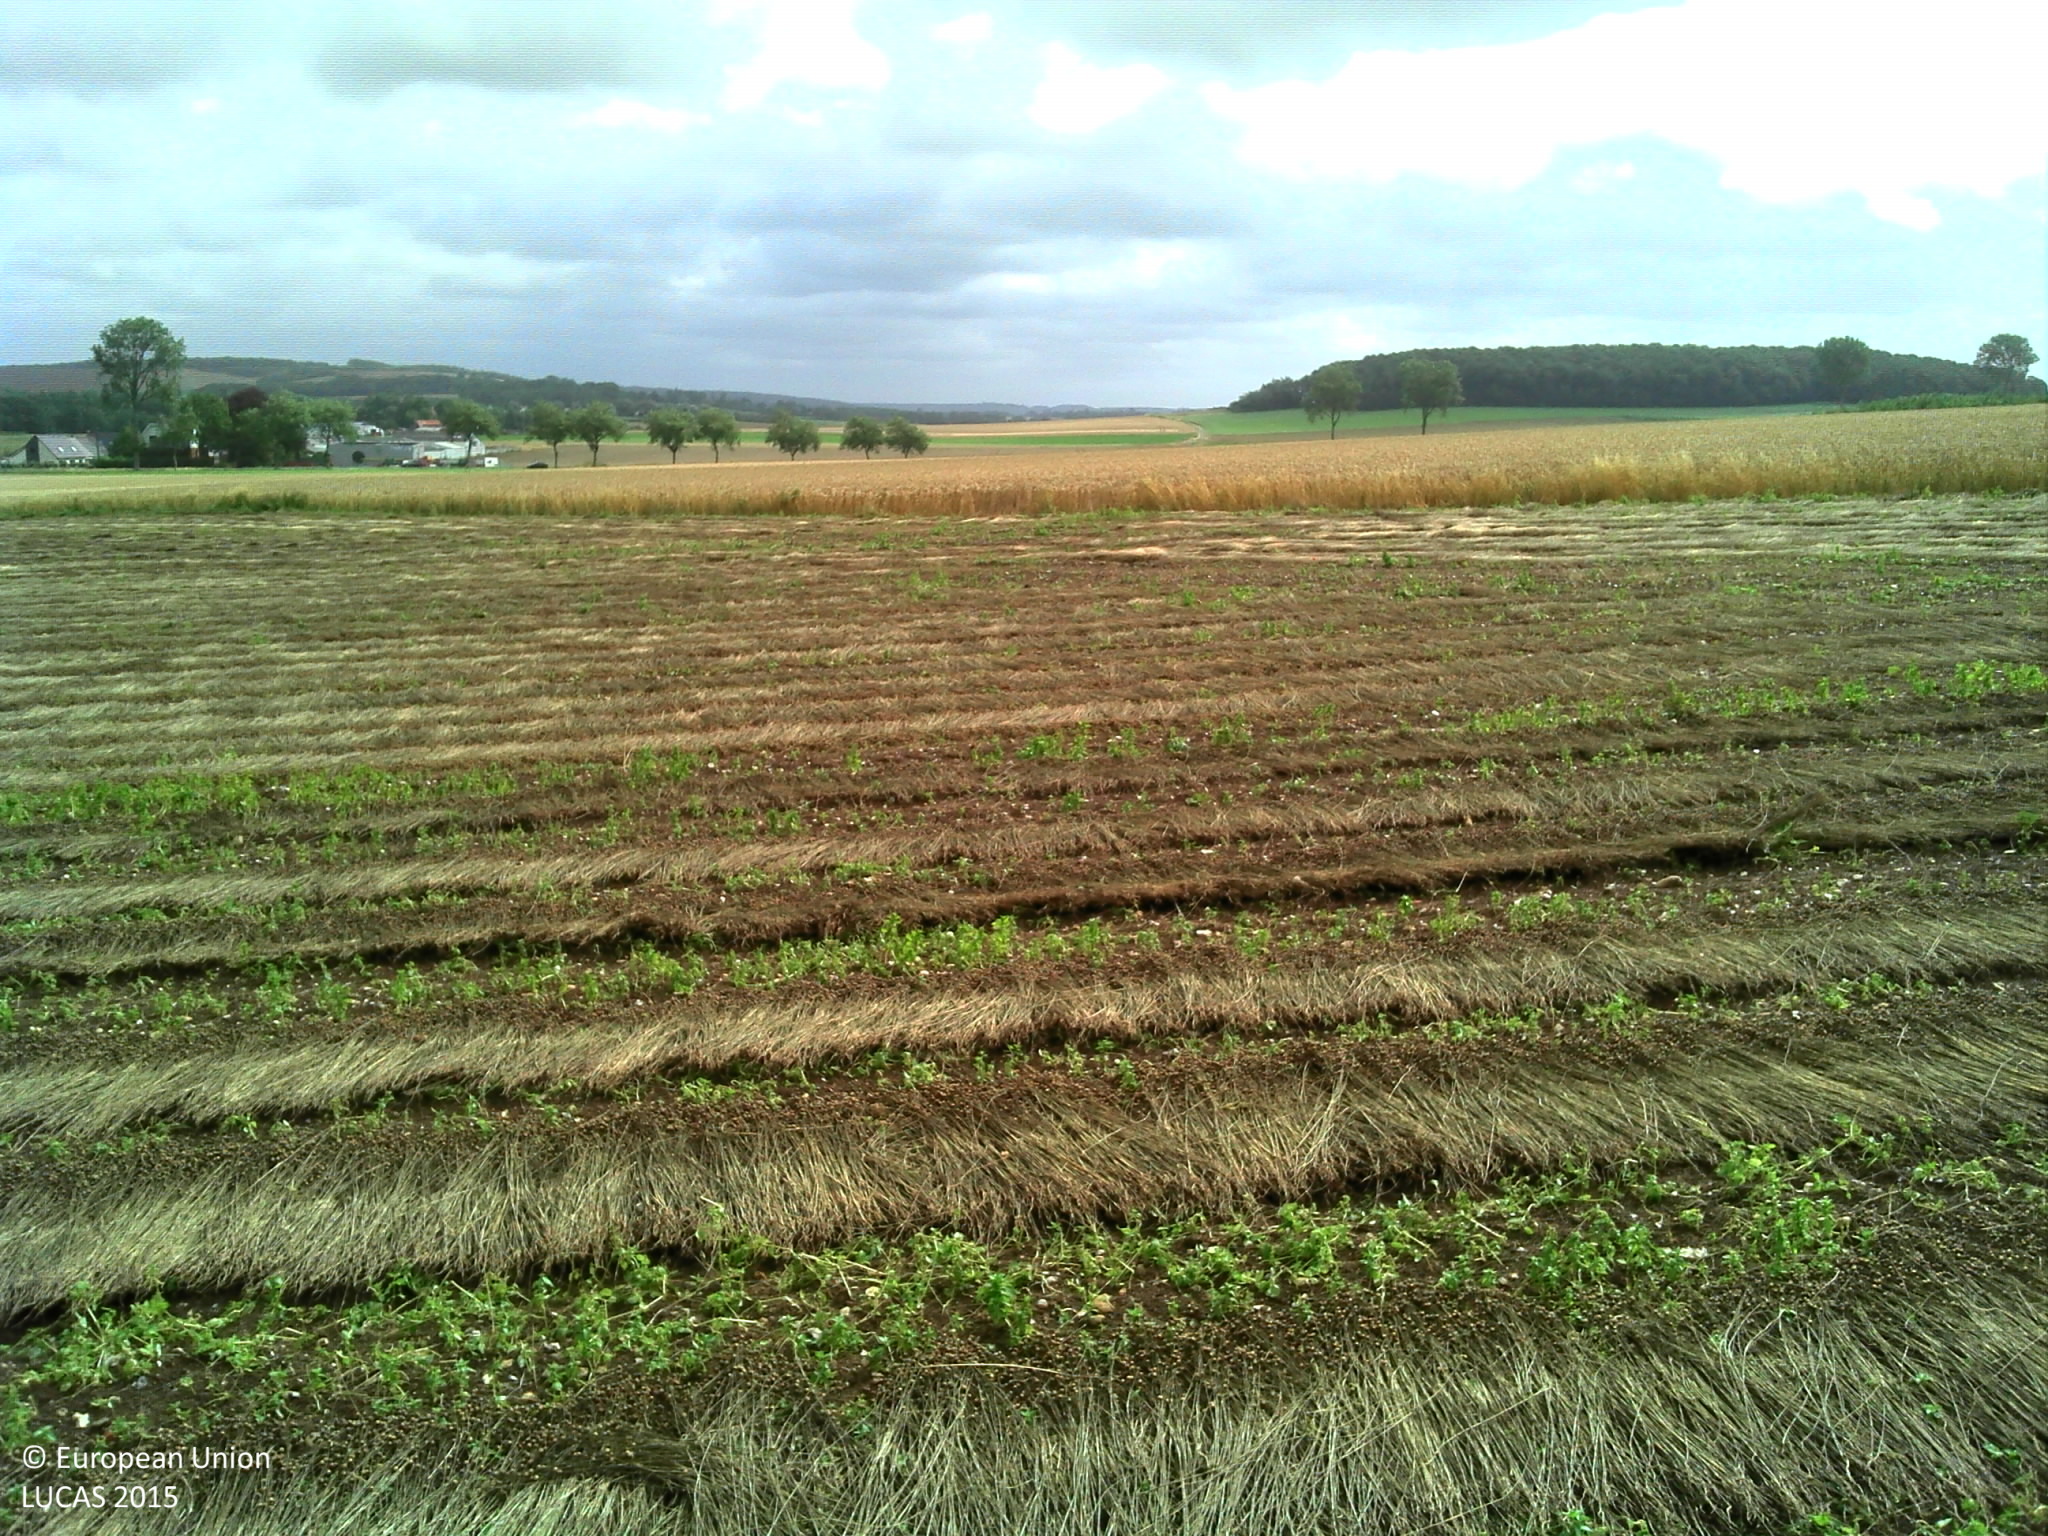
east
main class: Cropland
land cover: Other fibre and oleaginous crops
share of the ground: 50 - 75 %
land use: Agriculture (excluding fallow land and kitchen gardens)
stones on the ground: 10 - 25 %
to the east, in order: Other fibre and oleaginous crops; Common wheat; Sugar beet
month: July
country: FR
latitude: 50.8119
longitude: 2.0796
